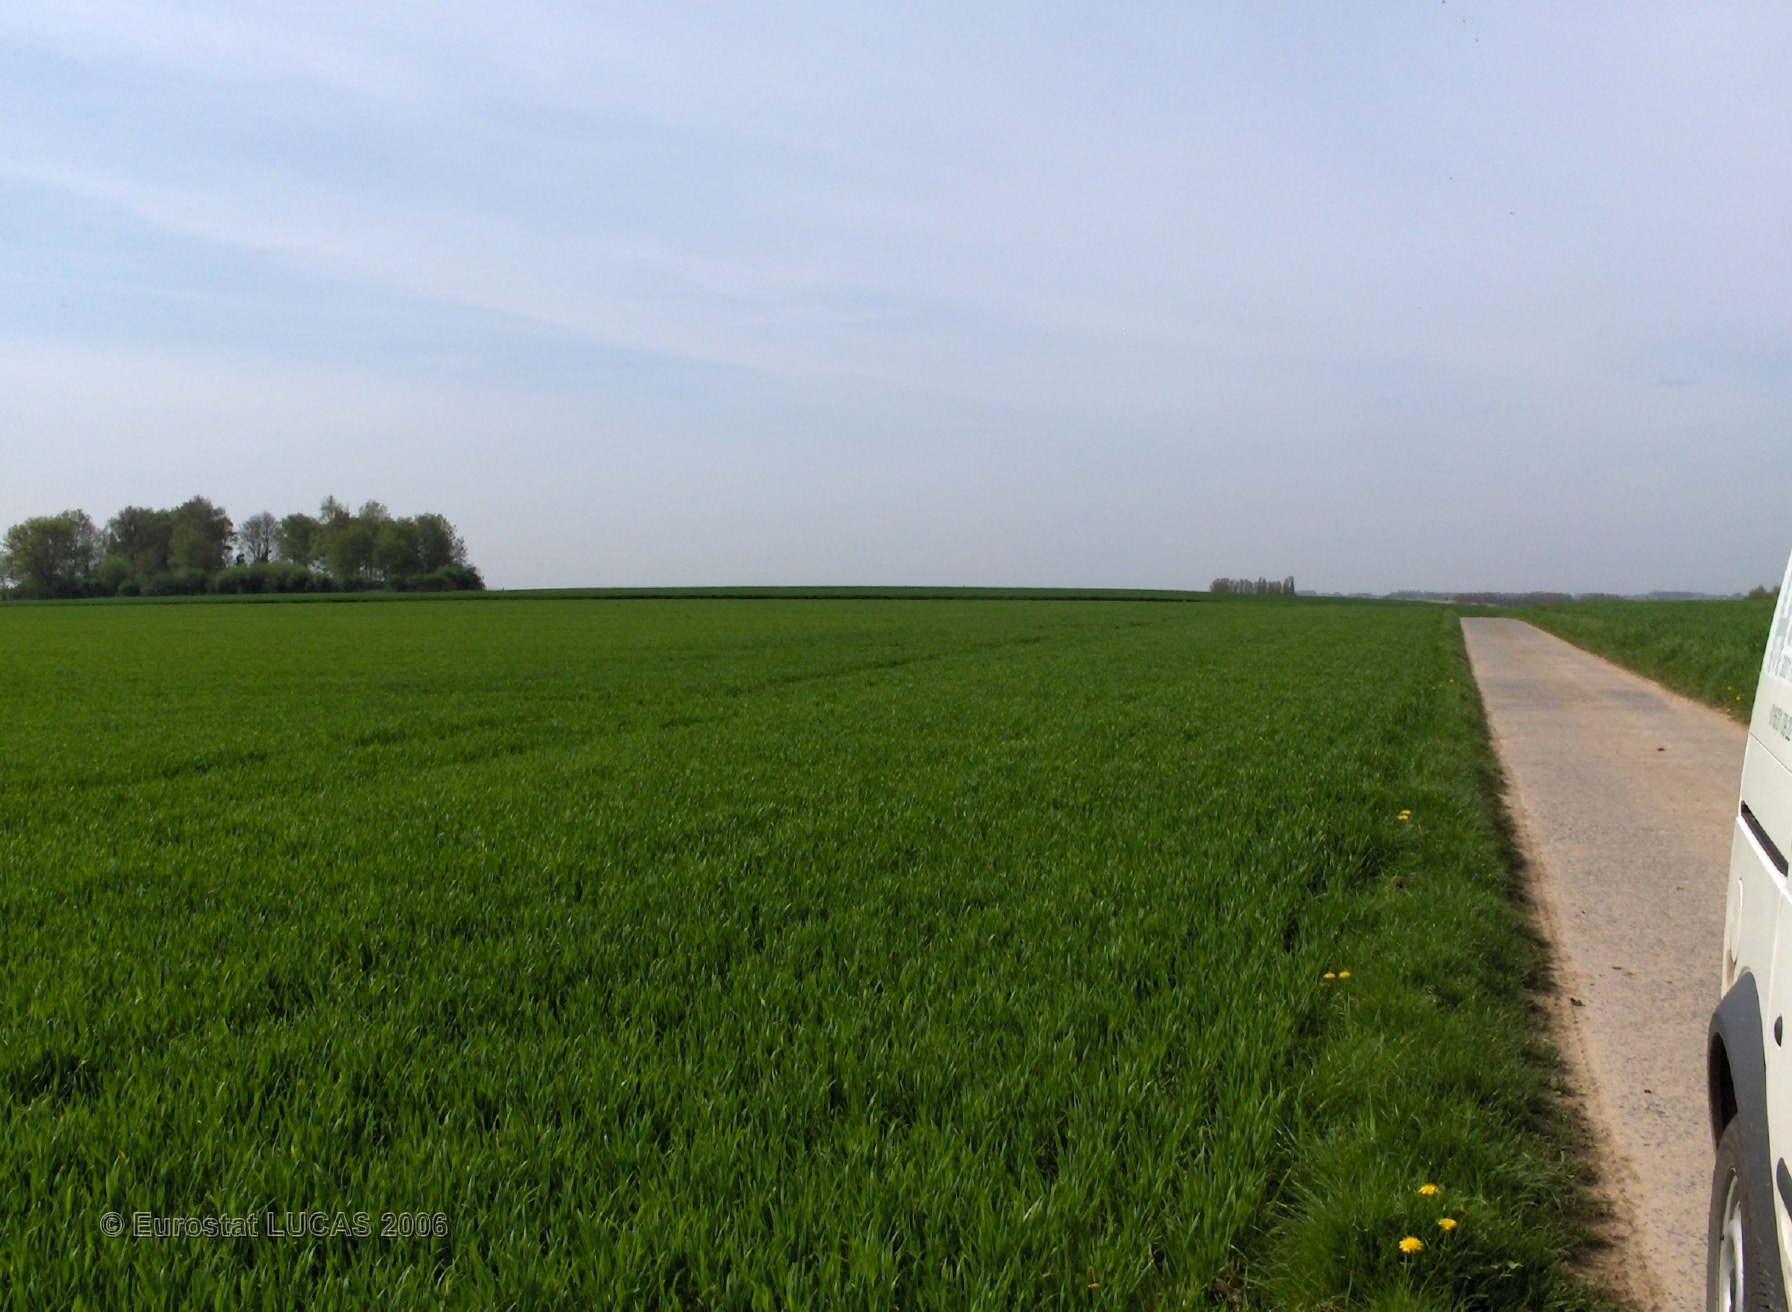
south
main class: Cropland
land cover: Common wheat
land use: Agriculture (excluding fallow land and kitchen gardens)
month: May
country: BE
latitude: 50.7673
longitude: 5.1910
